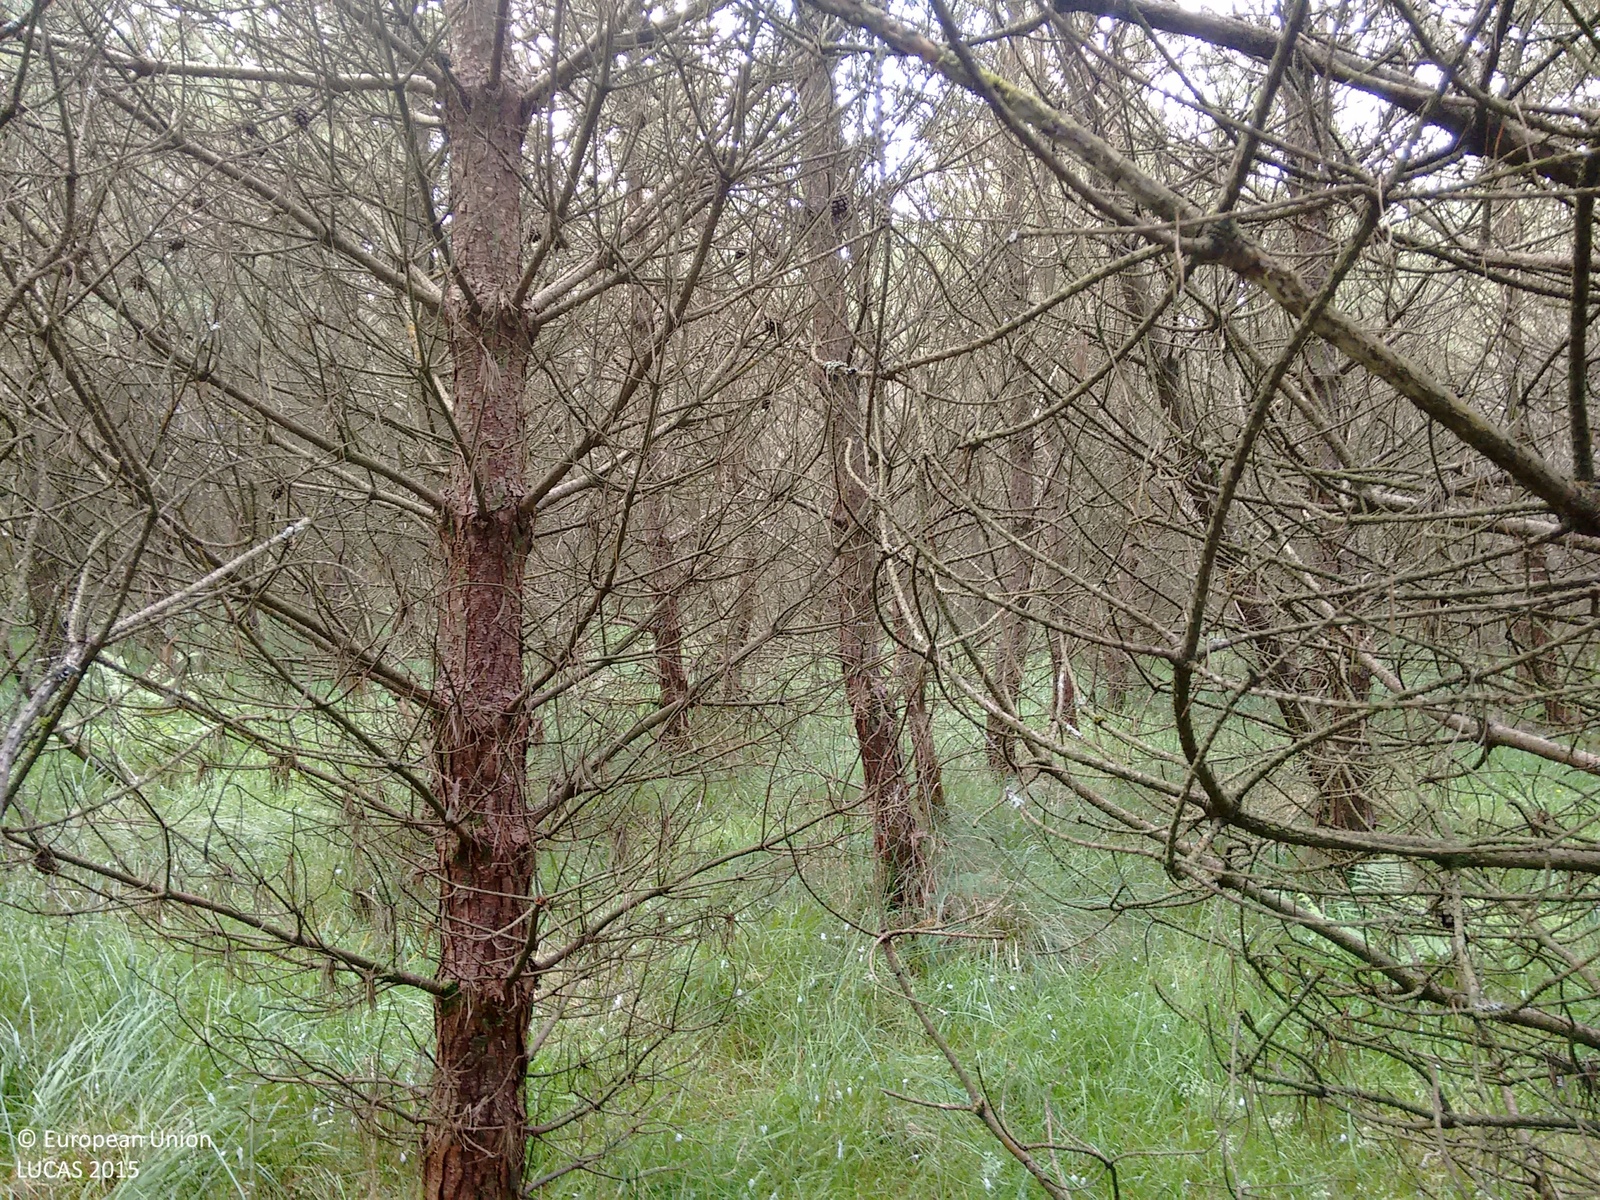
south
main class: Woodland
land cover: Pine dominated coniferous woodland
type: exotic forest
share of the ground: > 75 %
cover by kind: coniferous forest trees 100 %
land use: Forestry
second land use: Amenities, museums, leisure
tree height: > 5 m
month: August
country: GB
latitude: 55.9236
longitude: -3.8634
